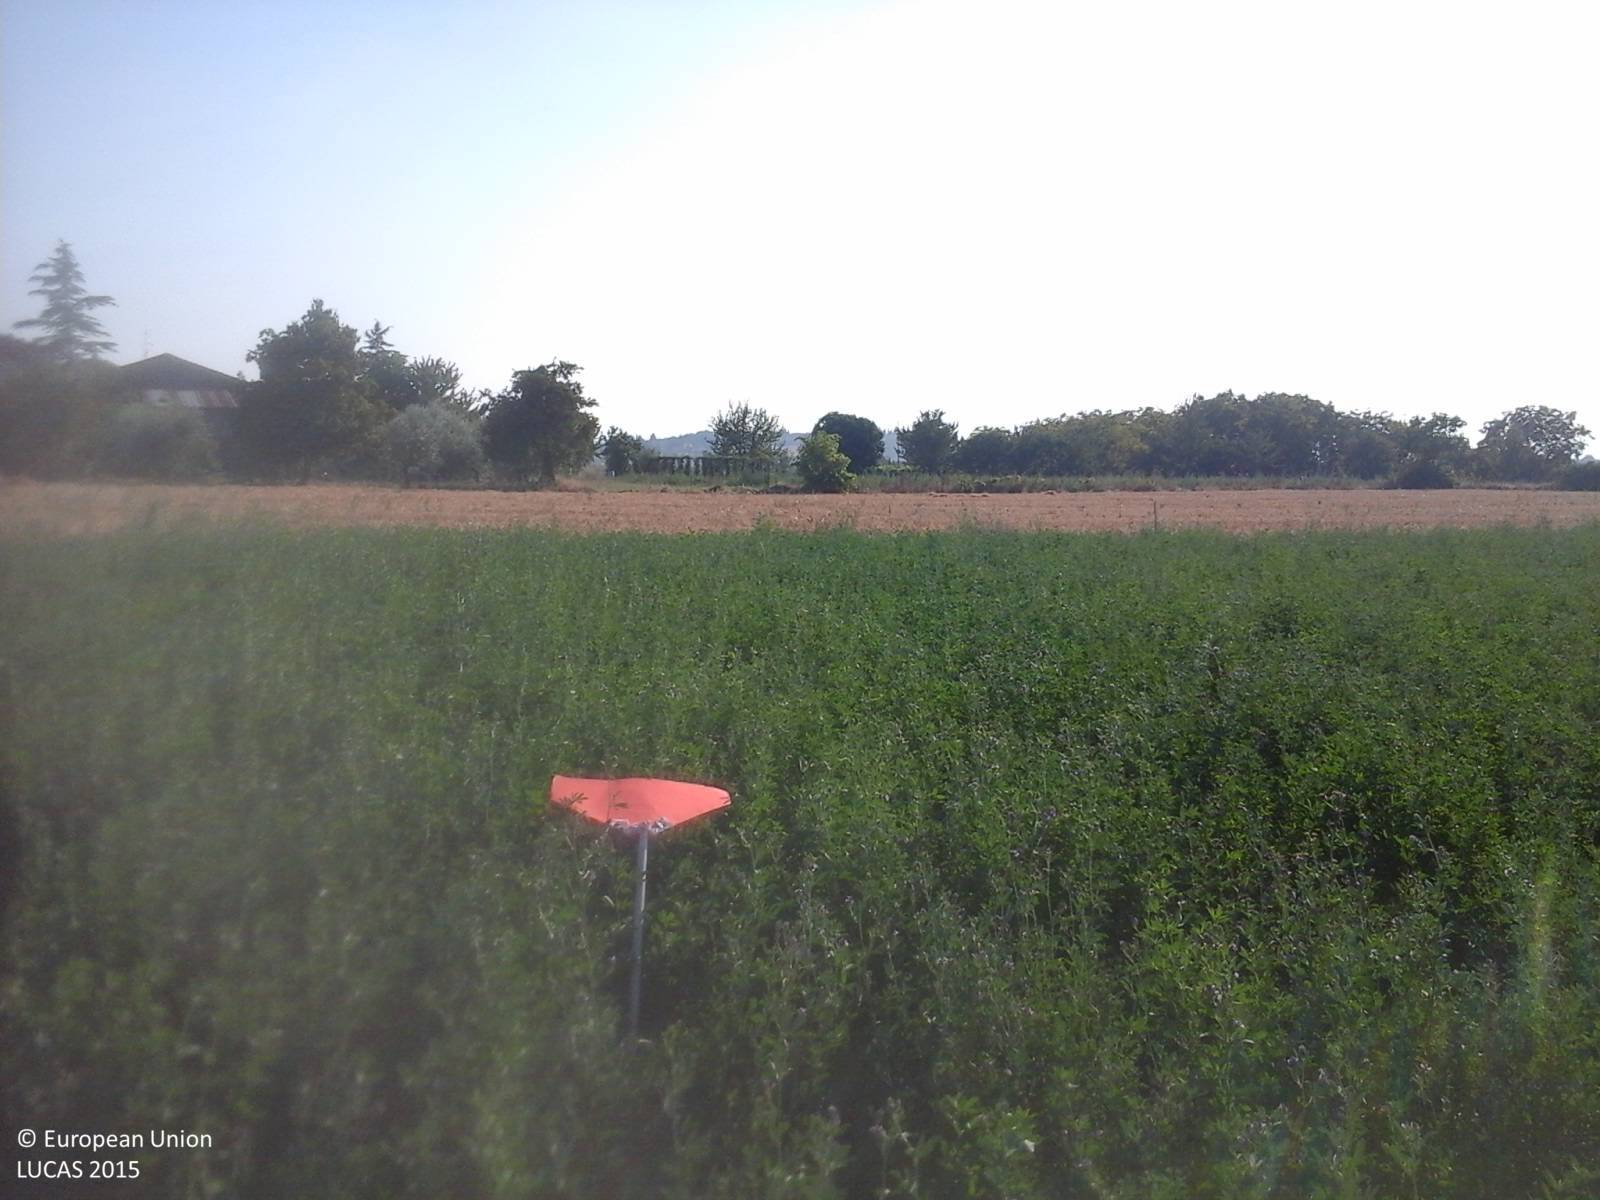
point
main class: Cropland
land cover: Lucerne
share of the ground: > 75 %
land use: Agriculture (excluding fallow land and kitchen gardens)
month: August
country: IT
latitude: 43.5213
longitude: 11.8878
